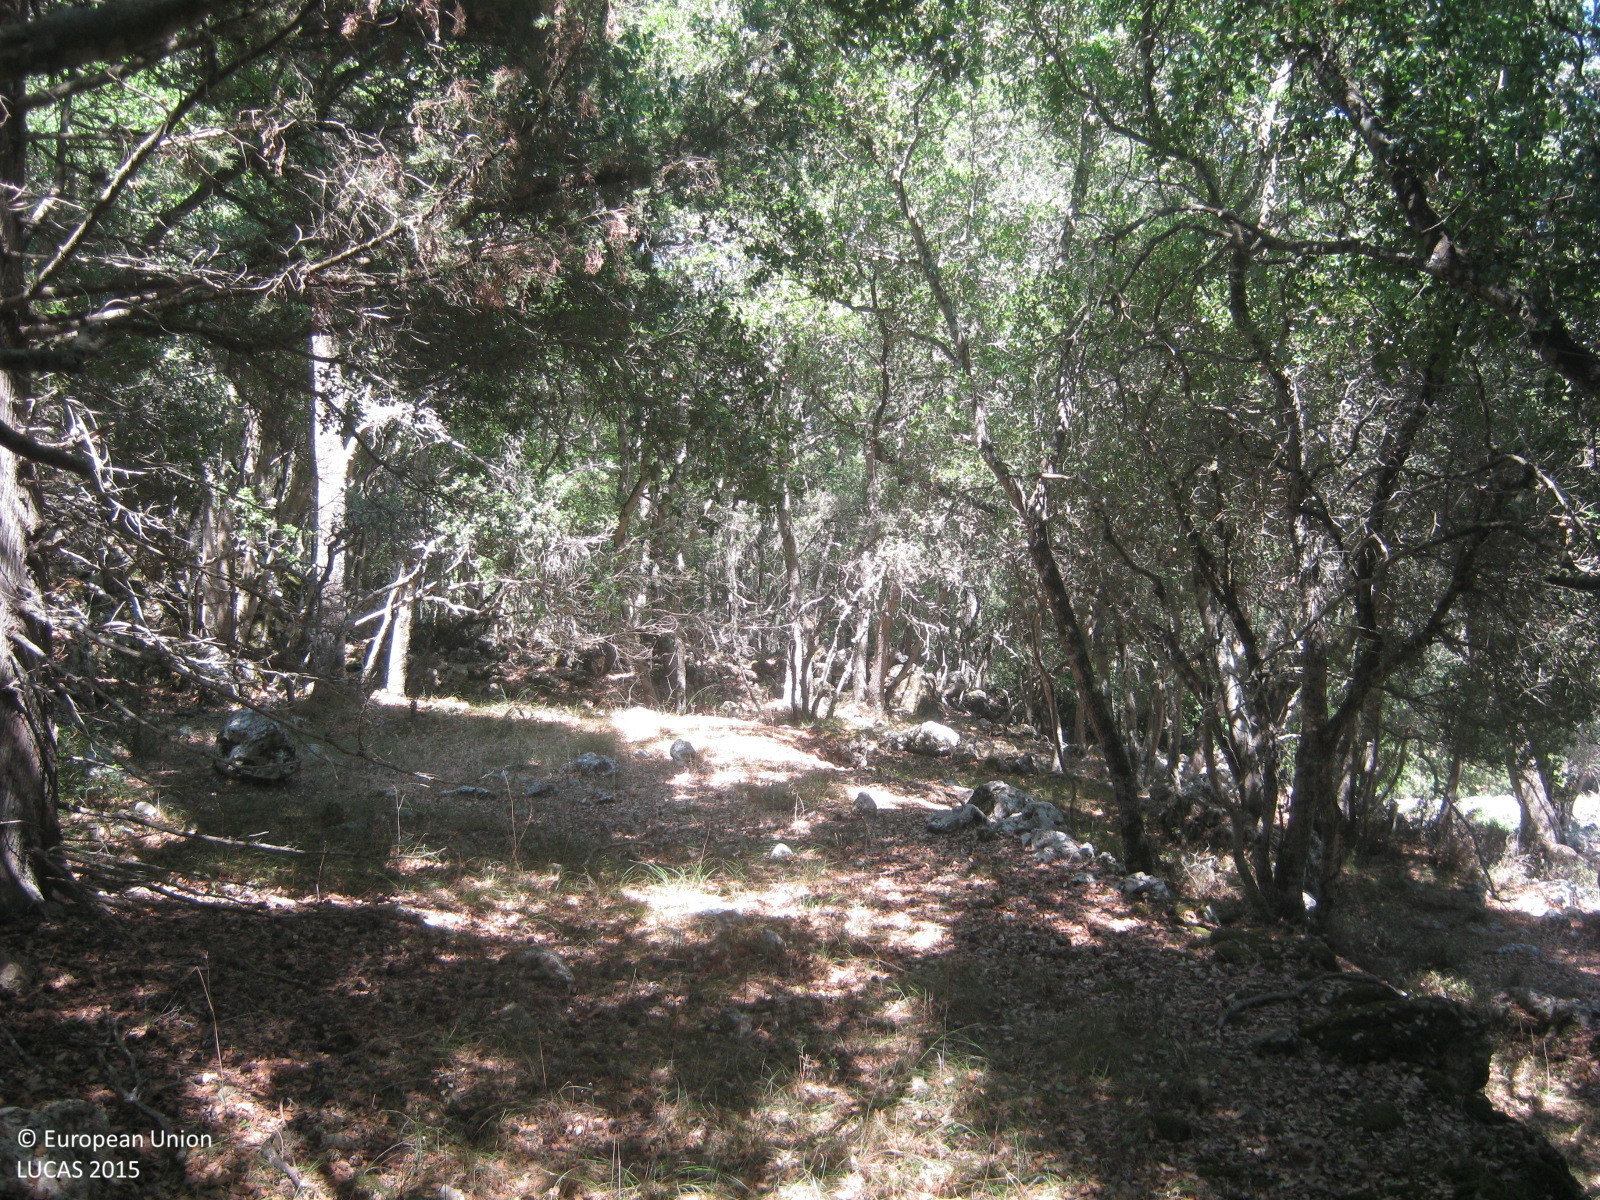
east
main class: Woodland
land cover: Broadleaved woodland
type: thermophilous deciduous forest
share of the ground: > 75 %
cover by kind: broadleaved forest trees 90 %, shrubs 5 %, consolidated bare surface 5 %
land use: Semi-natural and natural areas not in use
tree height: > 5 m
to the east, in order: Broadleaved woodland; Dry stone walls; Grassland without tree/shrub cover; Dry stone walls; Grassland without tree/shrub cover; Broadleaved woodland; Dry stone walls; Broadleaved woodland; Dry stone walls; Broadleaved woodland; Dry stone walls; Broadleaved woodland
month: July
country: GR
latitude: 38.4187
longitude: 20.5581
